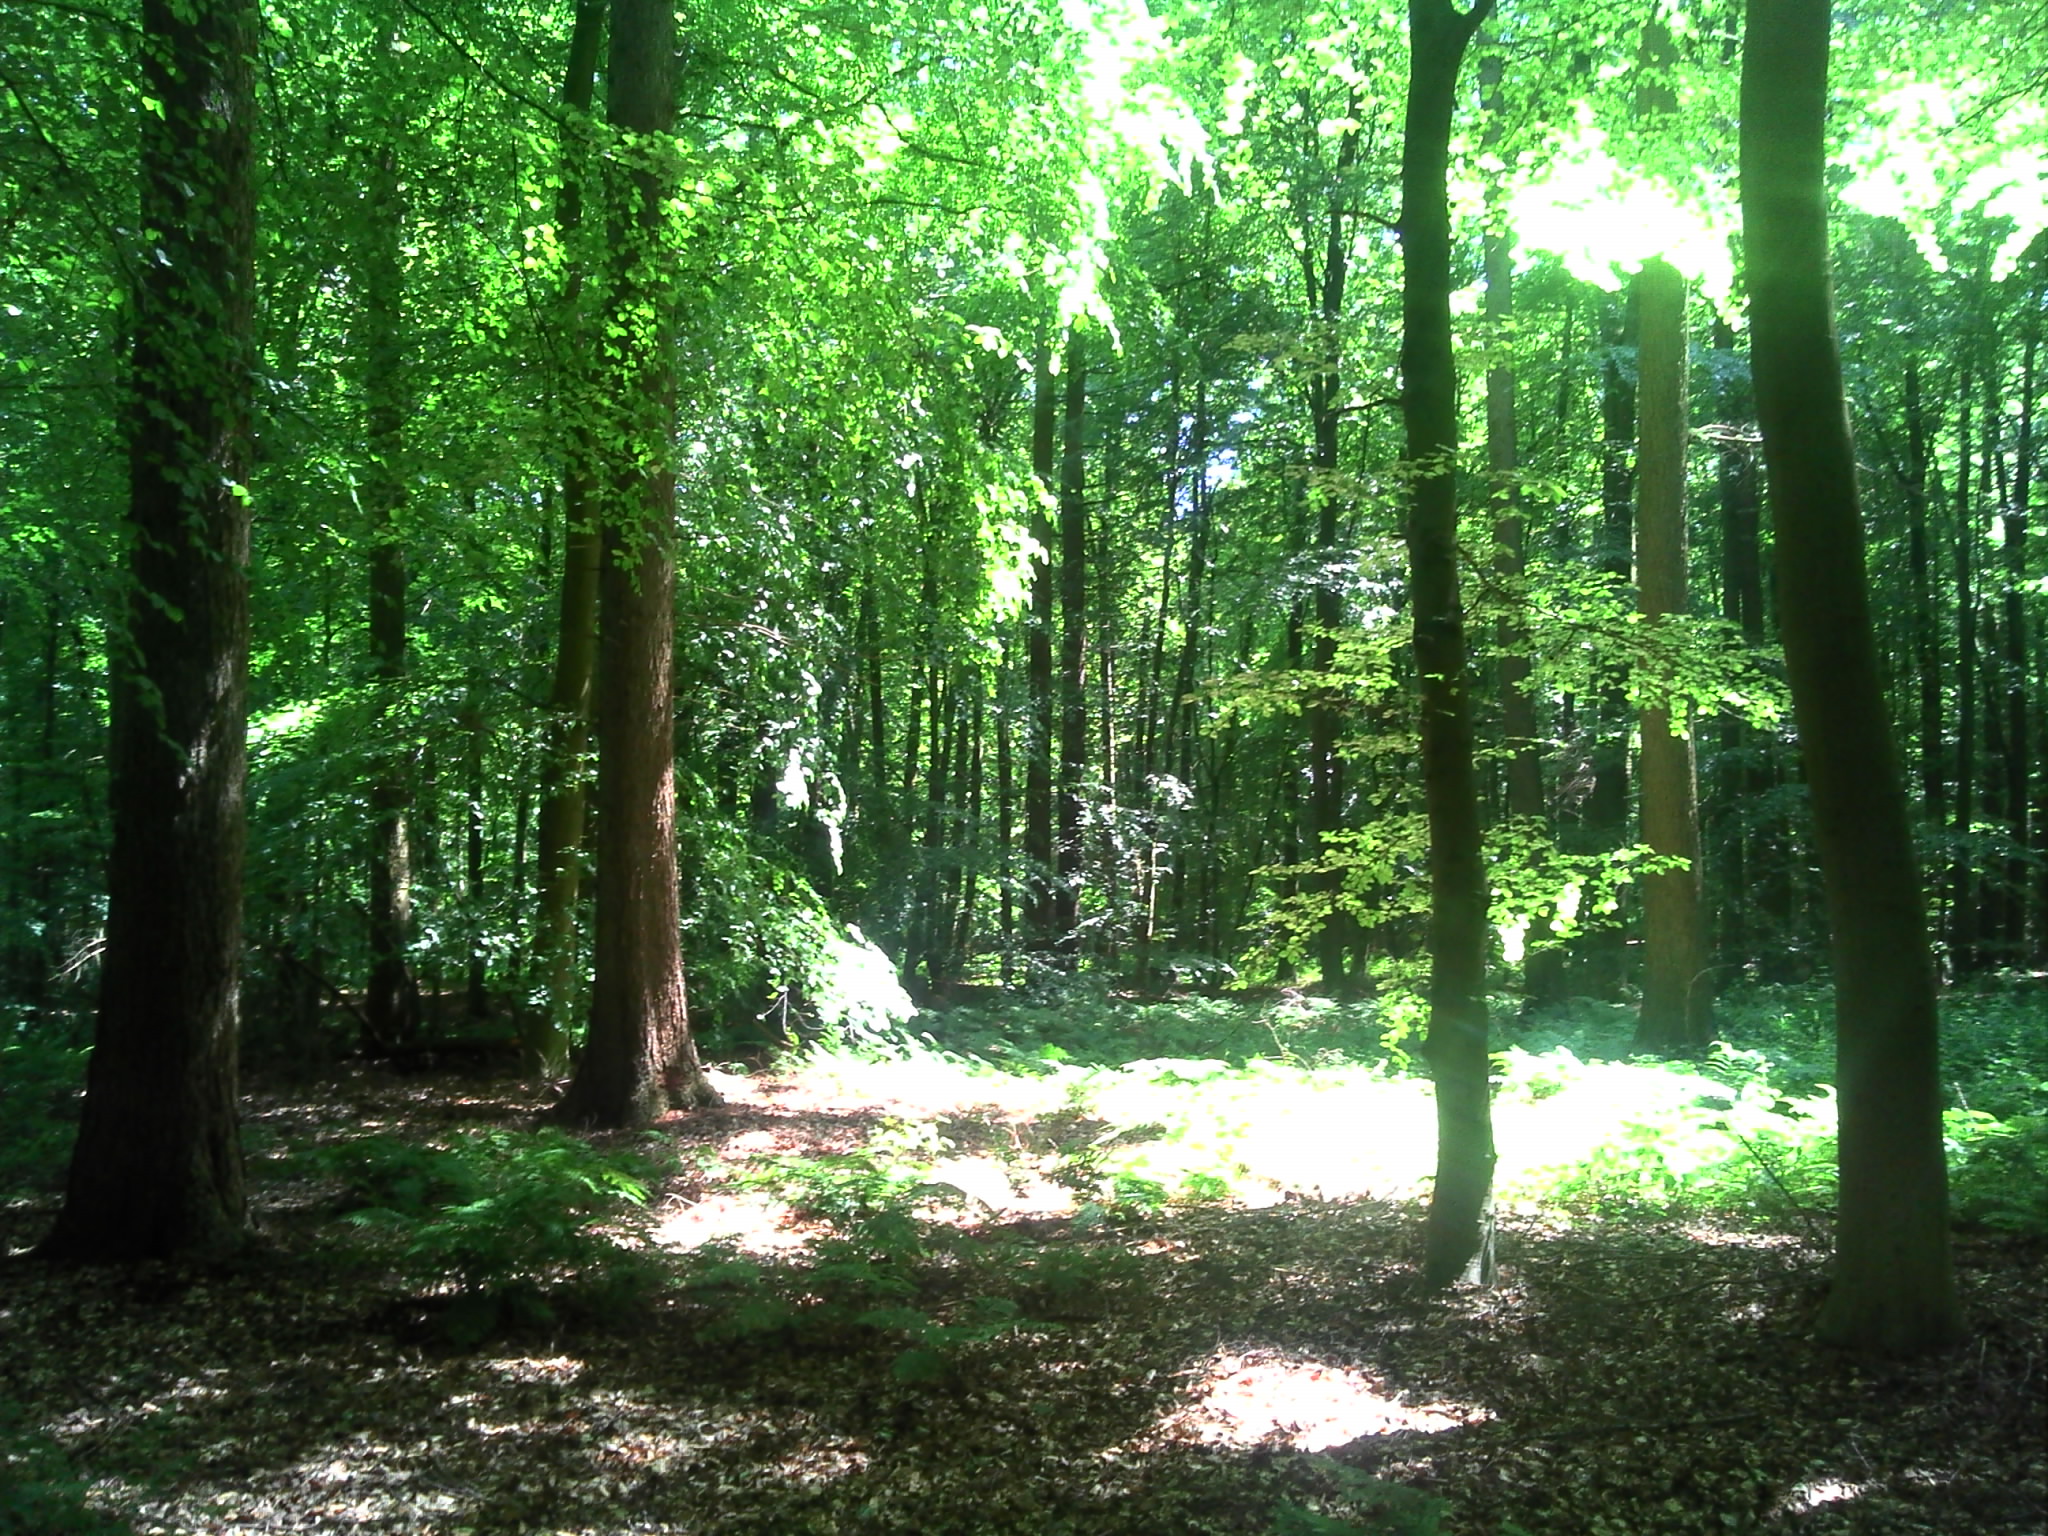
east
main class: Woodland
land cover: Broadleaved woodland
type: beech forest
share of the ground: > 75 %
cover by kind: broadleaved forest trees 80 %, shrubs 10 %, coniferous forest trees 5 %, herbaceous plants 5 %
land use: Forestry
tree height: > 5 m
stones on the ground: < 10 %
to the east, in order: Broadleaved woodland; Tracks; Broadleaved woodland
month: June
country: BE
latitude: 50.7495
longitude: 4.3970
